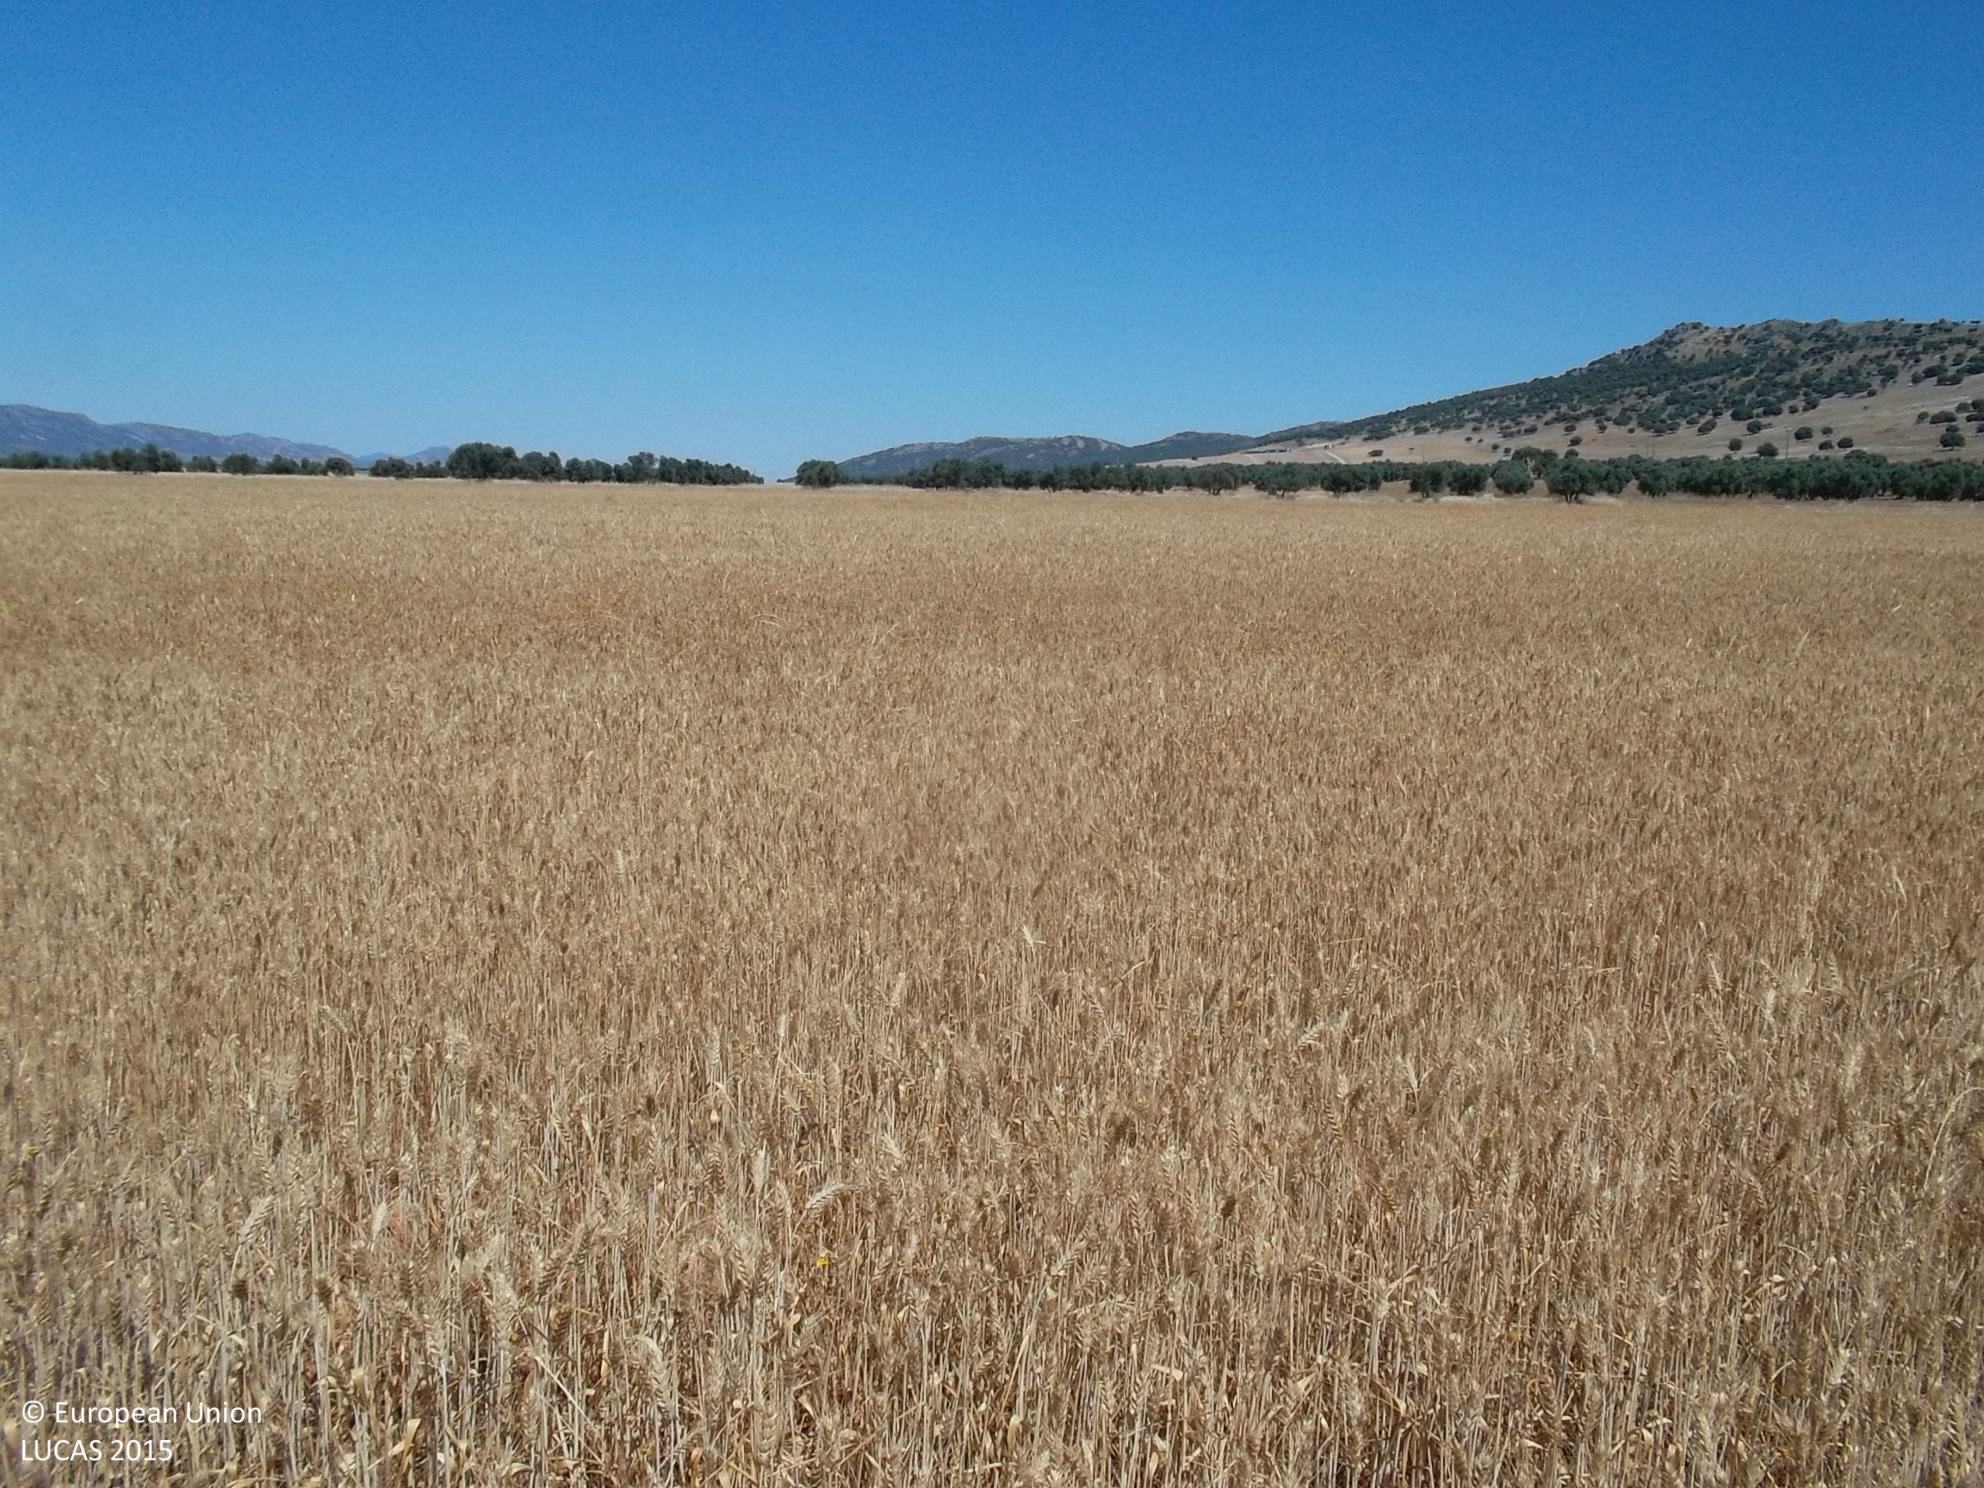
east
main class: Cropland
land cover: Common wheat
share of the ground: 50 - 75 %
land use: Agriculture (excluding fallow land and kitchen gardens)
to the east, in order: Common wheat; Grassland without tree/shrub cover; Grass margins; Lines of trees; Grassland without tree/shrub cover; Grass margins; Lines of trees; Grassland without tree/shrub cover
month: June
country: ES
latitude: 39.1506
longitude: -4.1075
